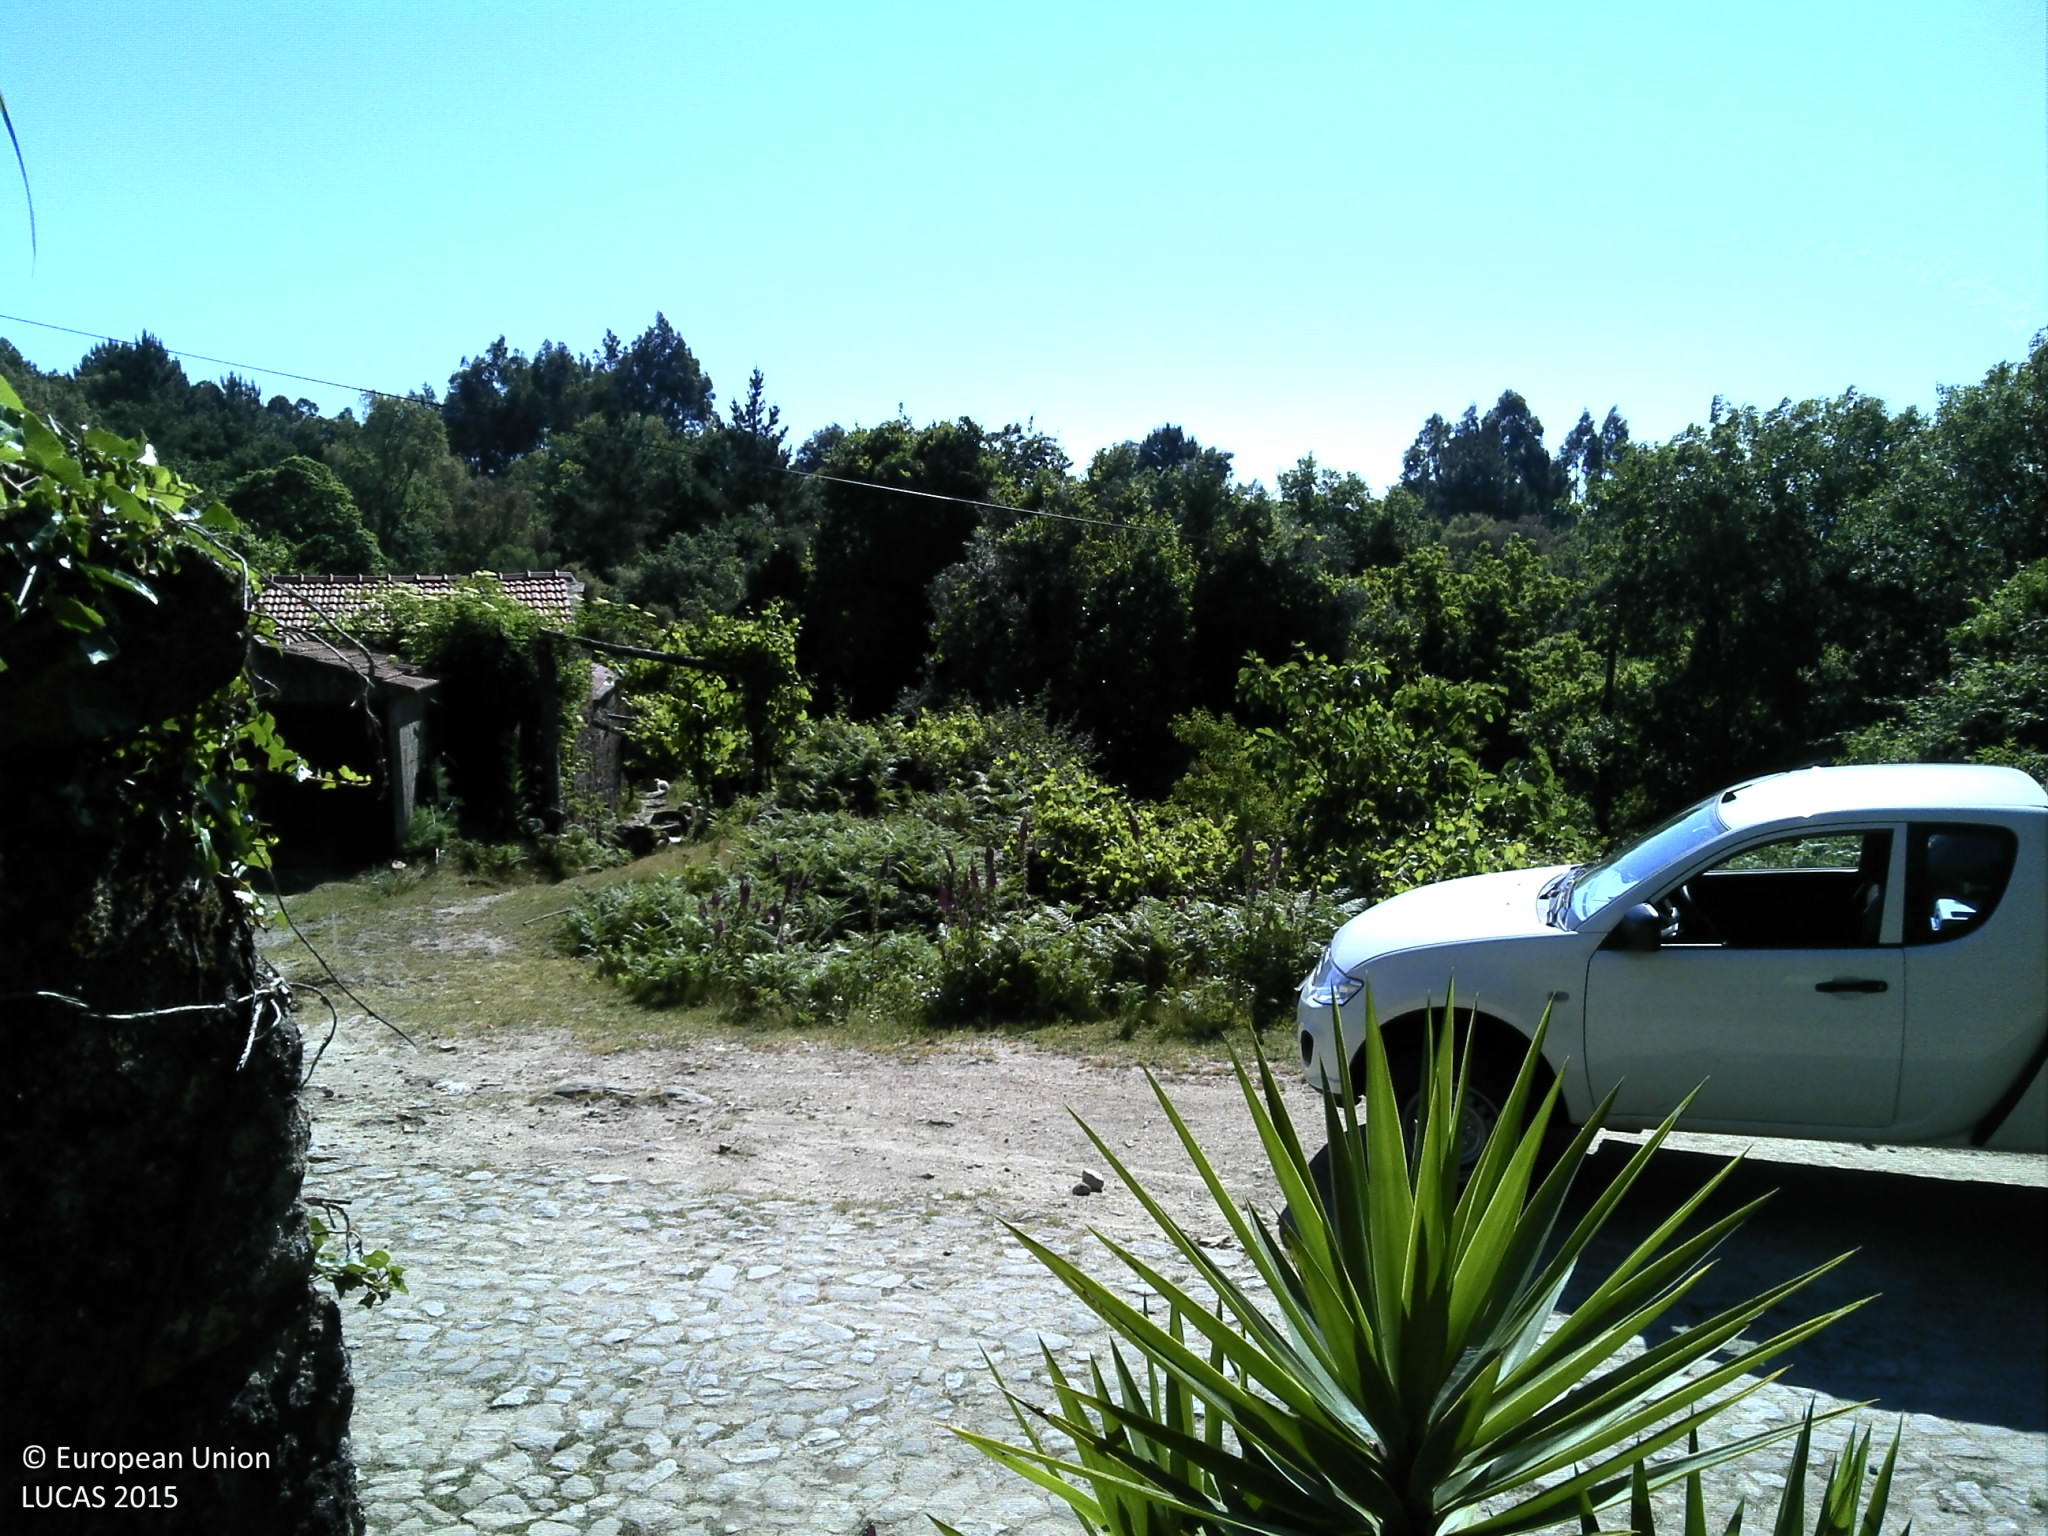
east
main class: Shrubland
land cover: Shrubland with sparse tree cover
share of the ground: 50 - 75 %
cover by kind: shrubs 60 %, unconsolidated bare surface 20 %, herbaceous plants 15 %, broadleaved forest trees 5 %
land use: Semi-natural and natural areas not in use
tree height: > 5 m
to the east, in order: Shrubland with sparse tree cover; Paved roads, cycling and walking lanes; Electric lines; Paved roads, cycling and walking lanes; Grass margins; Vineyards; Grassland without tree/shrub cover; Electric lines; Grassland without tree/shrub cover; Dry stone walls; Grassland without tree/shrub cover; Fences; Grassland without tree/shrub cover; Dry stone walls; Broadleaved woodland; Pine dominated mixed woodland
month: May
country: PT
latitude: 41.9112
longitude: -8.6982
